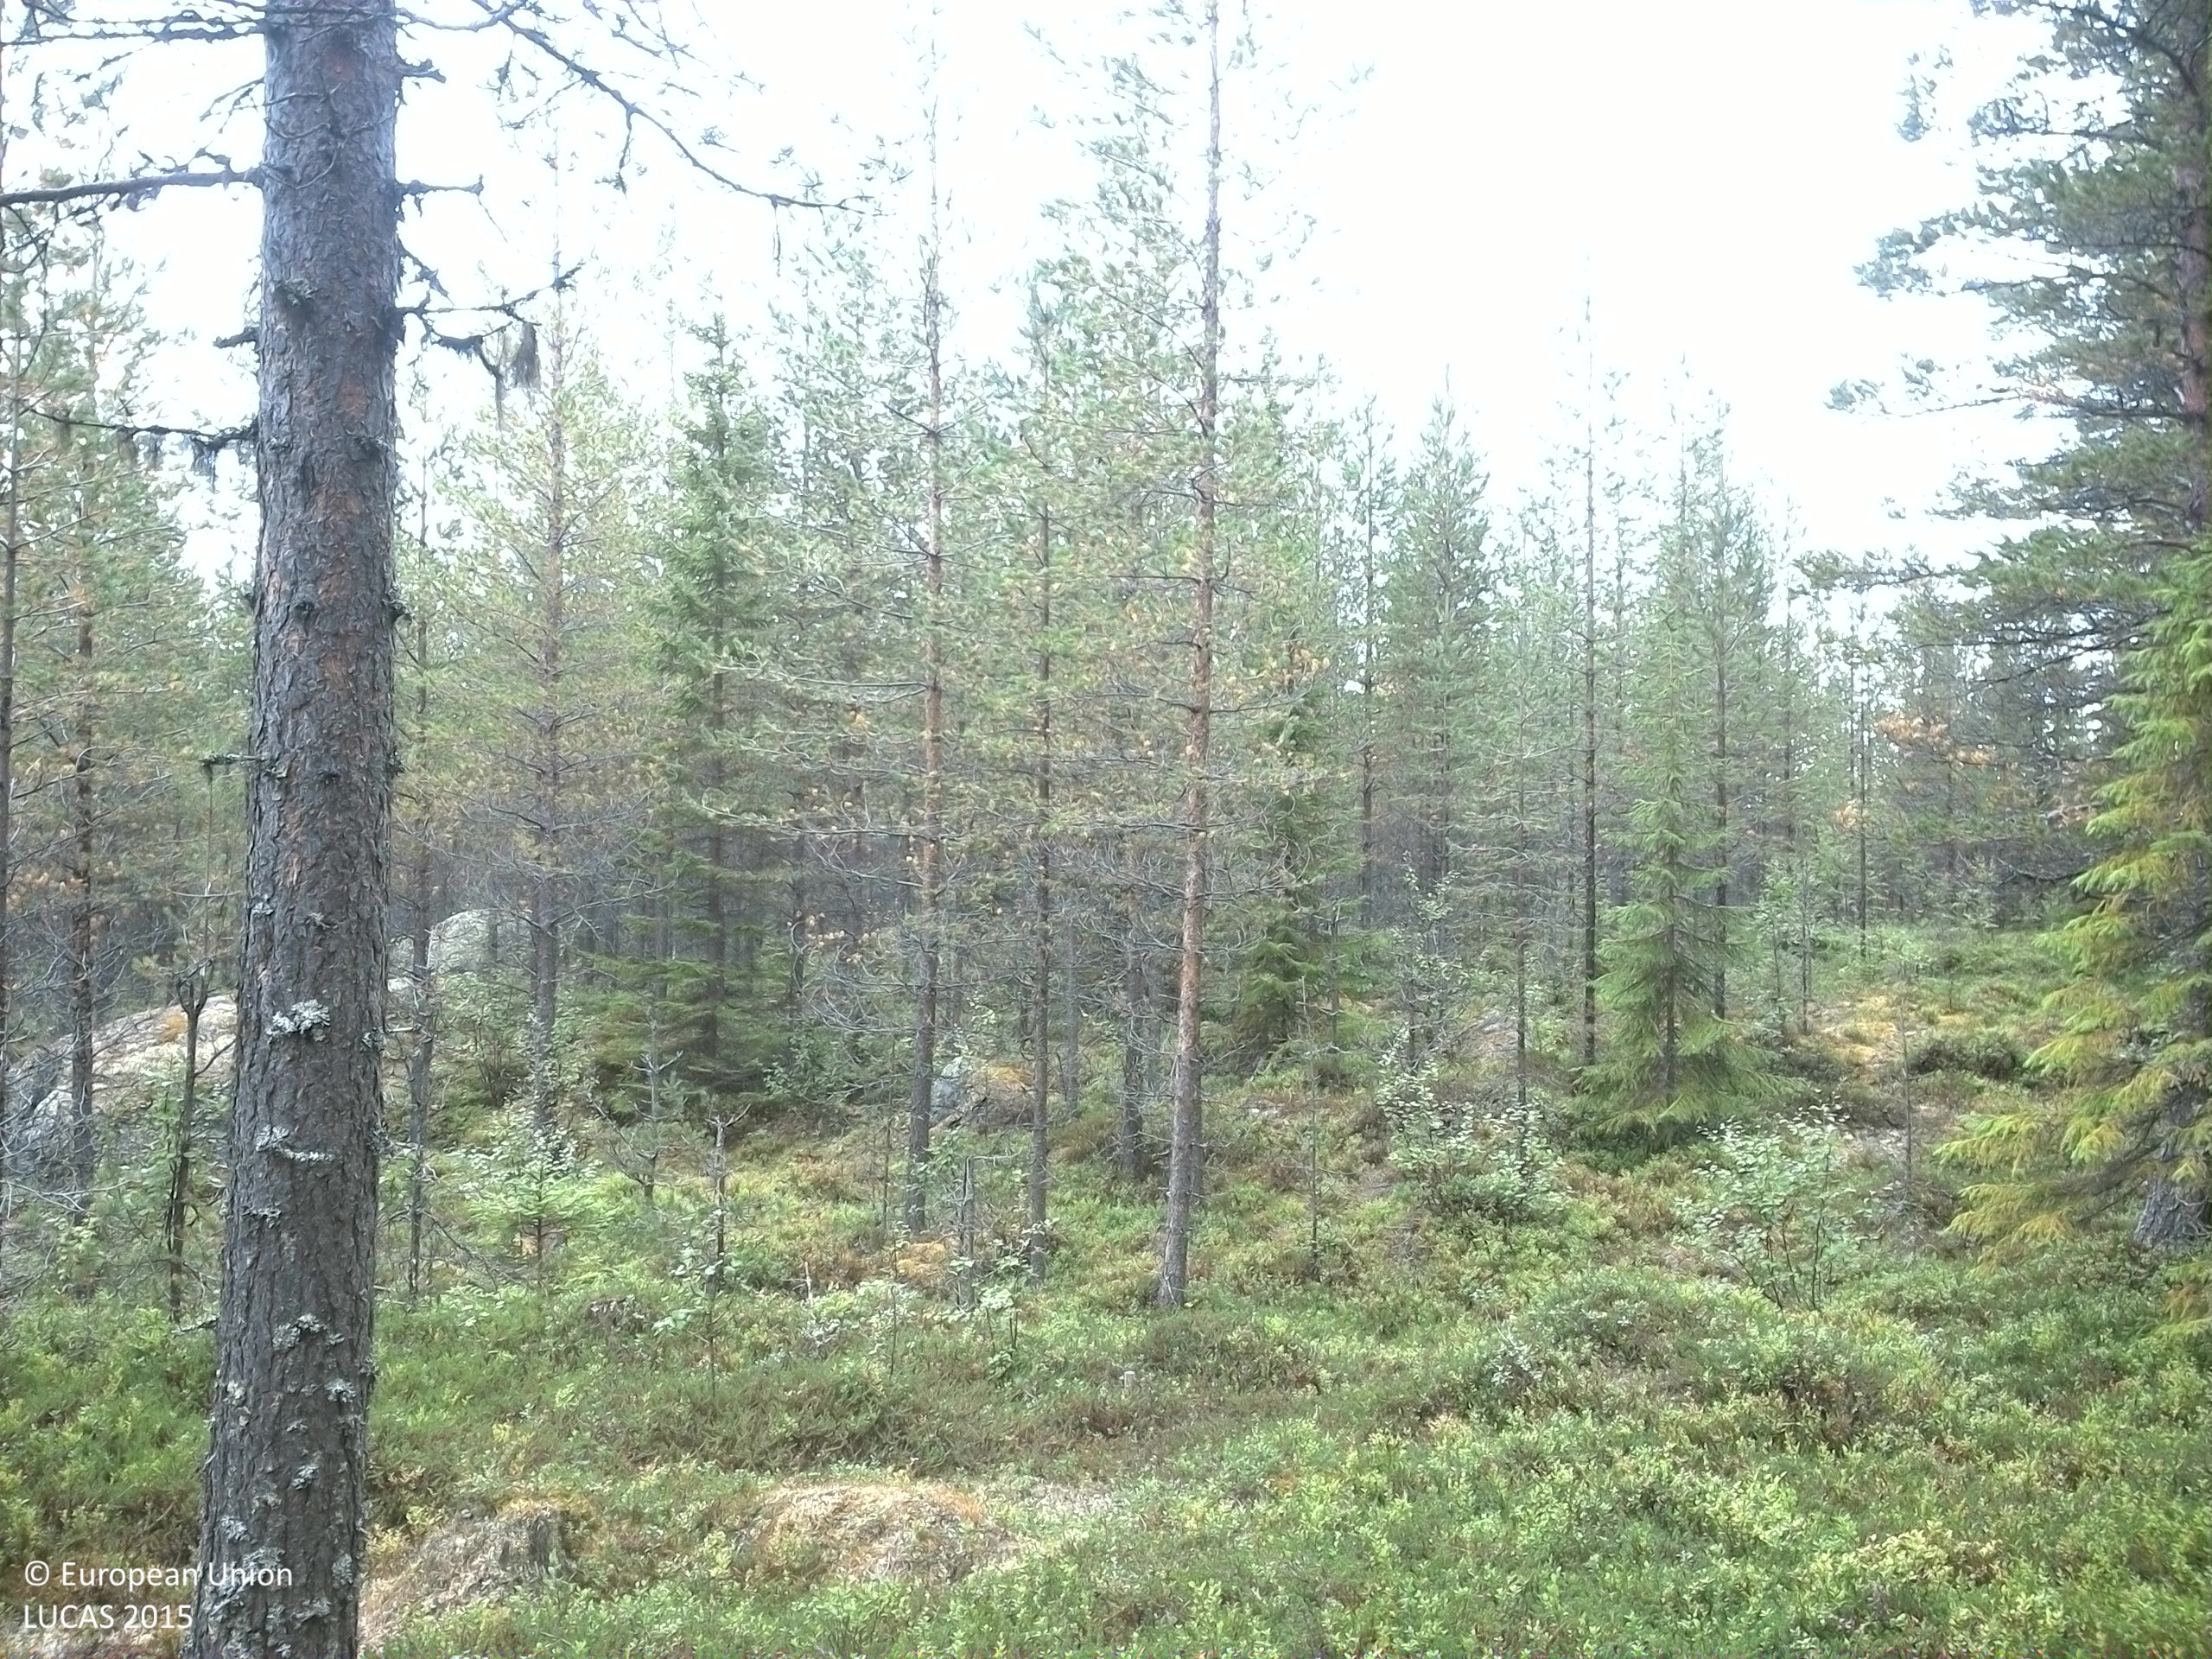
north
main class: Woodland
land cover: Pine dominated coniferous woodland
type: boreal forest
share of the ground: > 75 %
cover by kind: coniferous forest trees 70 %, shrubs 15 %, lichens and mosses 15 %
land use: Forestry
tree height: > 5 m
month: August
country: SE
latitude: 63.9580
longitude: 17.2999
